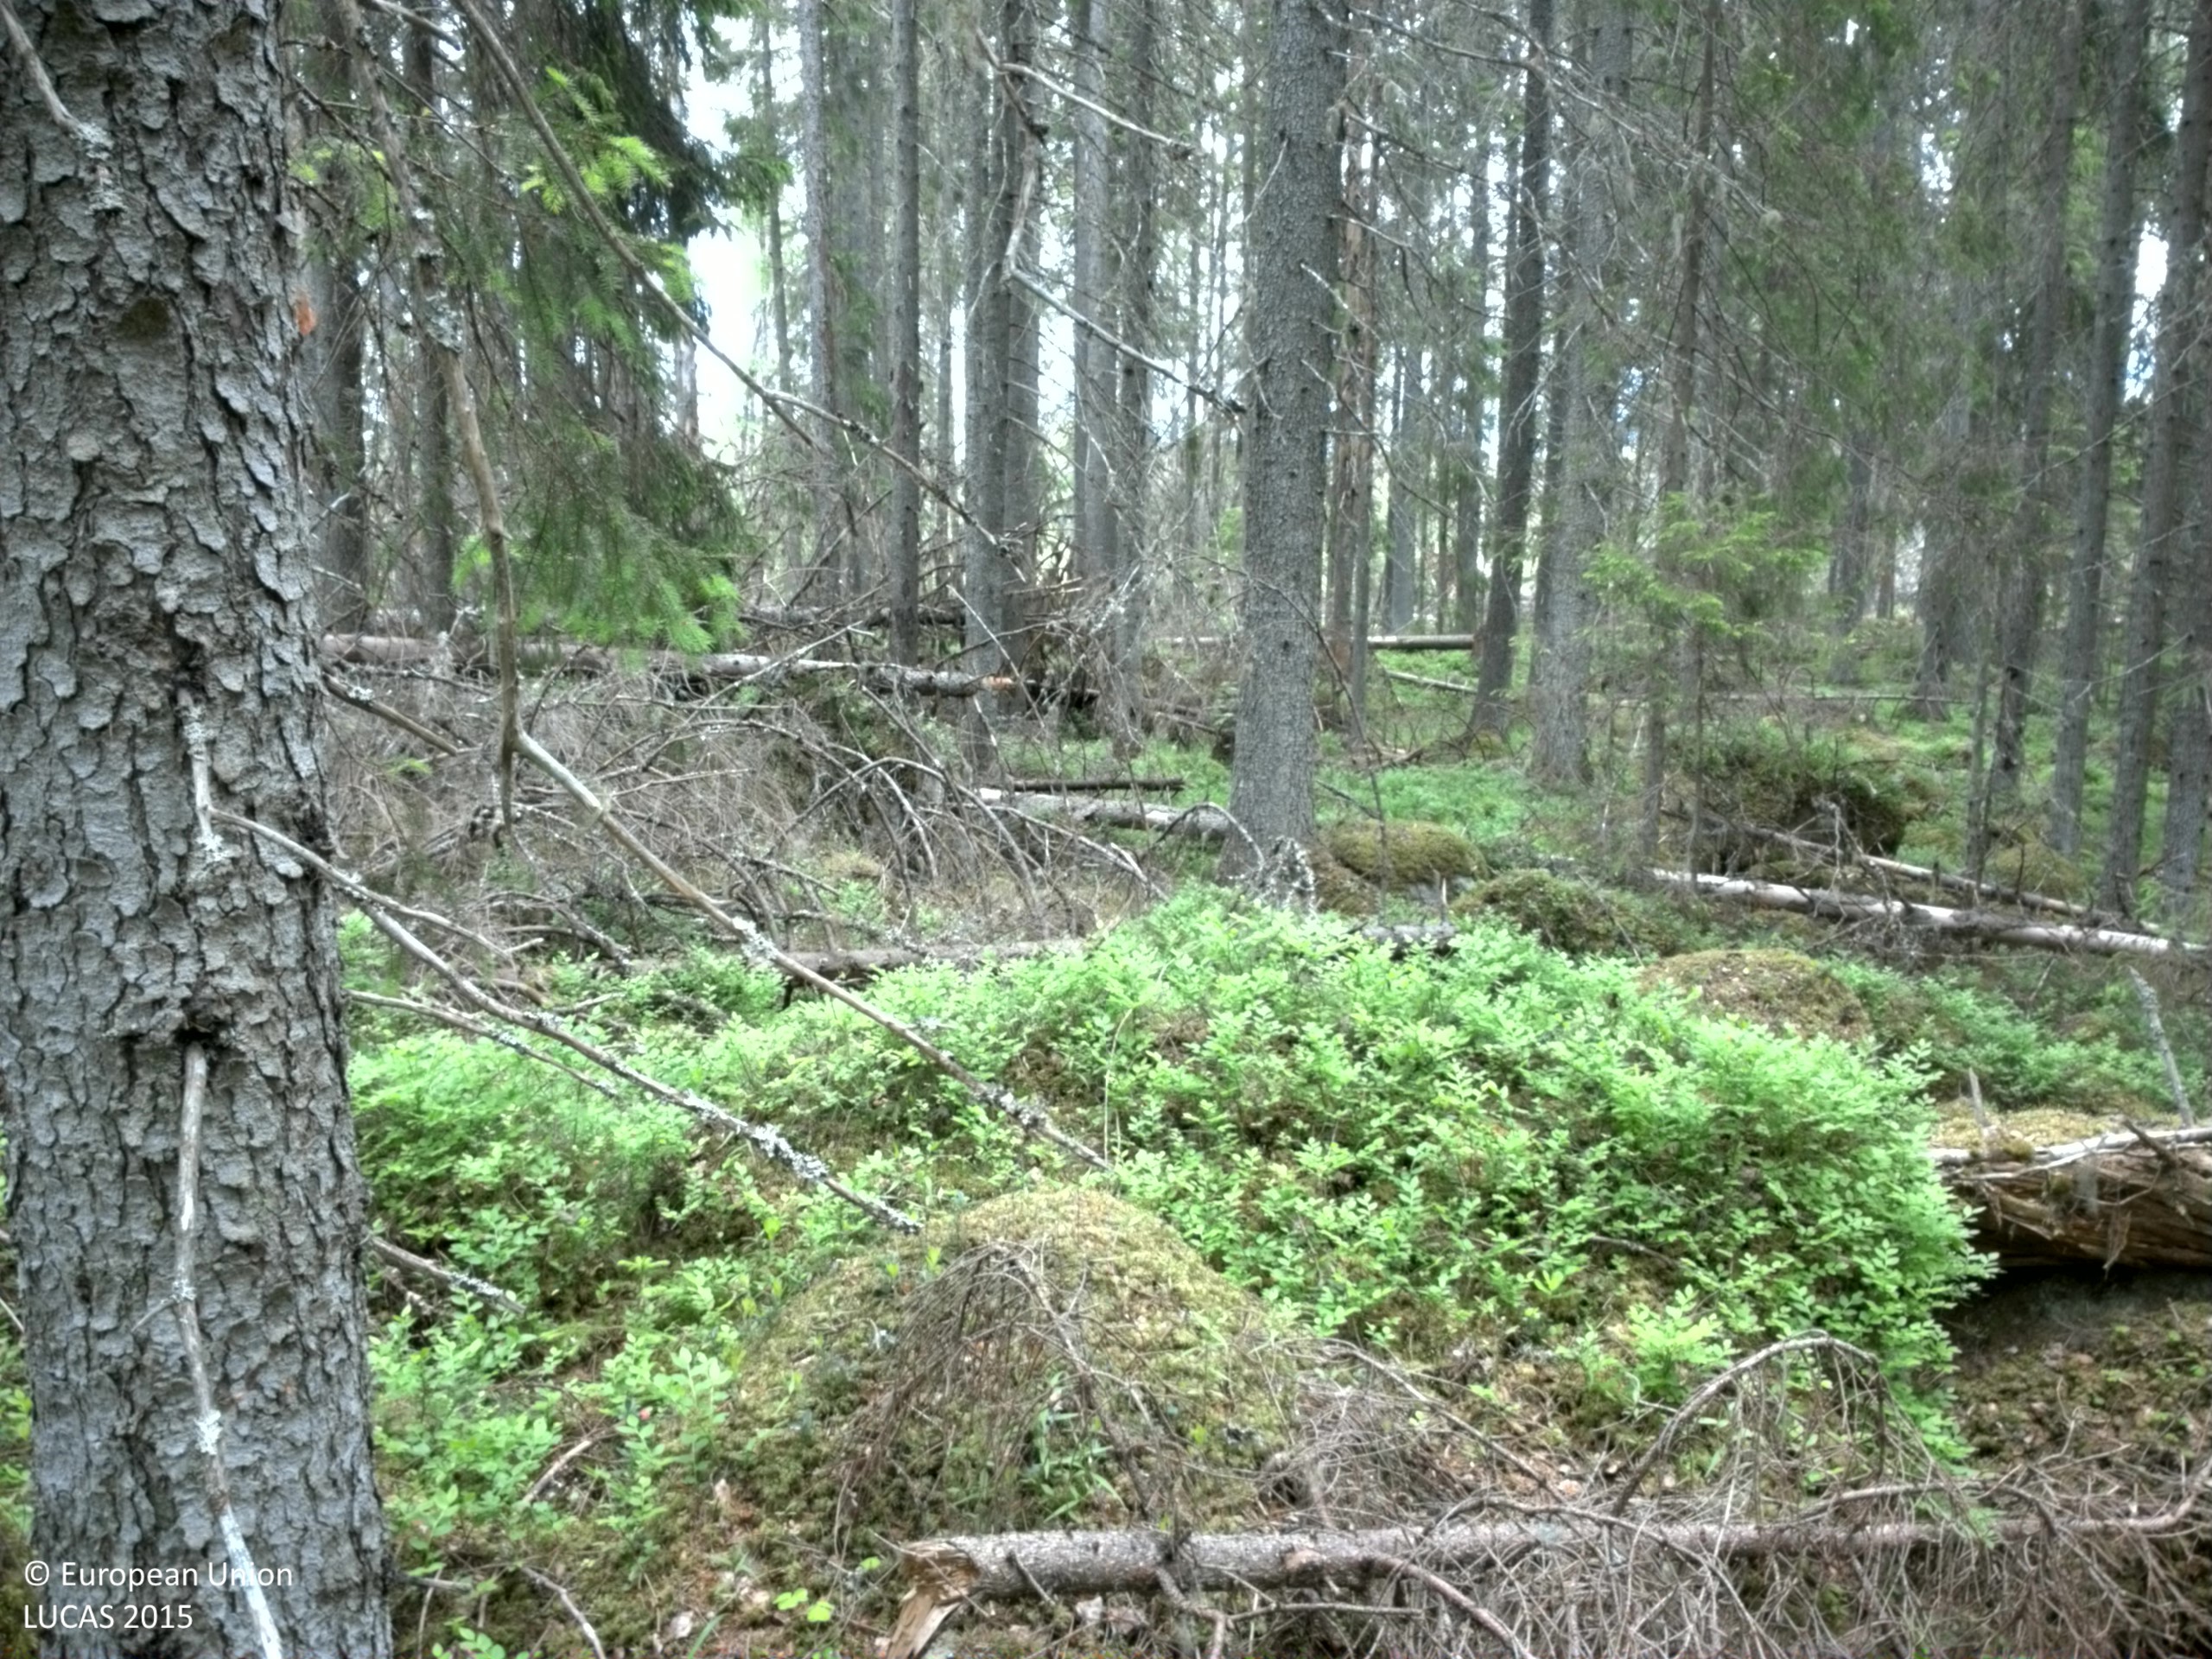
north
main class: Woodland
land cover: Spruce dominated coniferous woodland
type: boreal forest
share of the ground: > 75 %
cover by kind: coniferous forest trees 75 %, shrubs 10 %, lichens and mosses 10 %, broadleaved forest trees 5 %
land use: Forestry
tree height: > 5 m
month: June
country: SE
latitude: 60.3109
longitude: 17.7577
